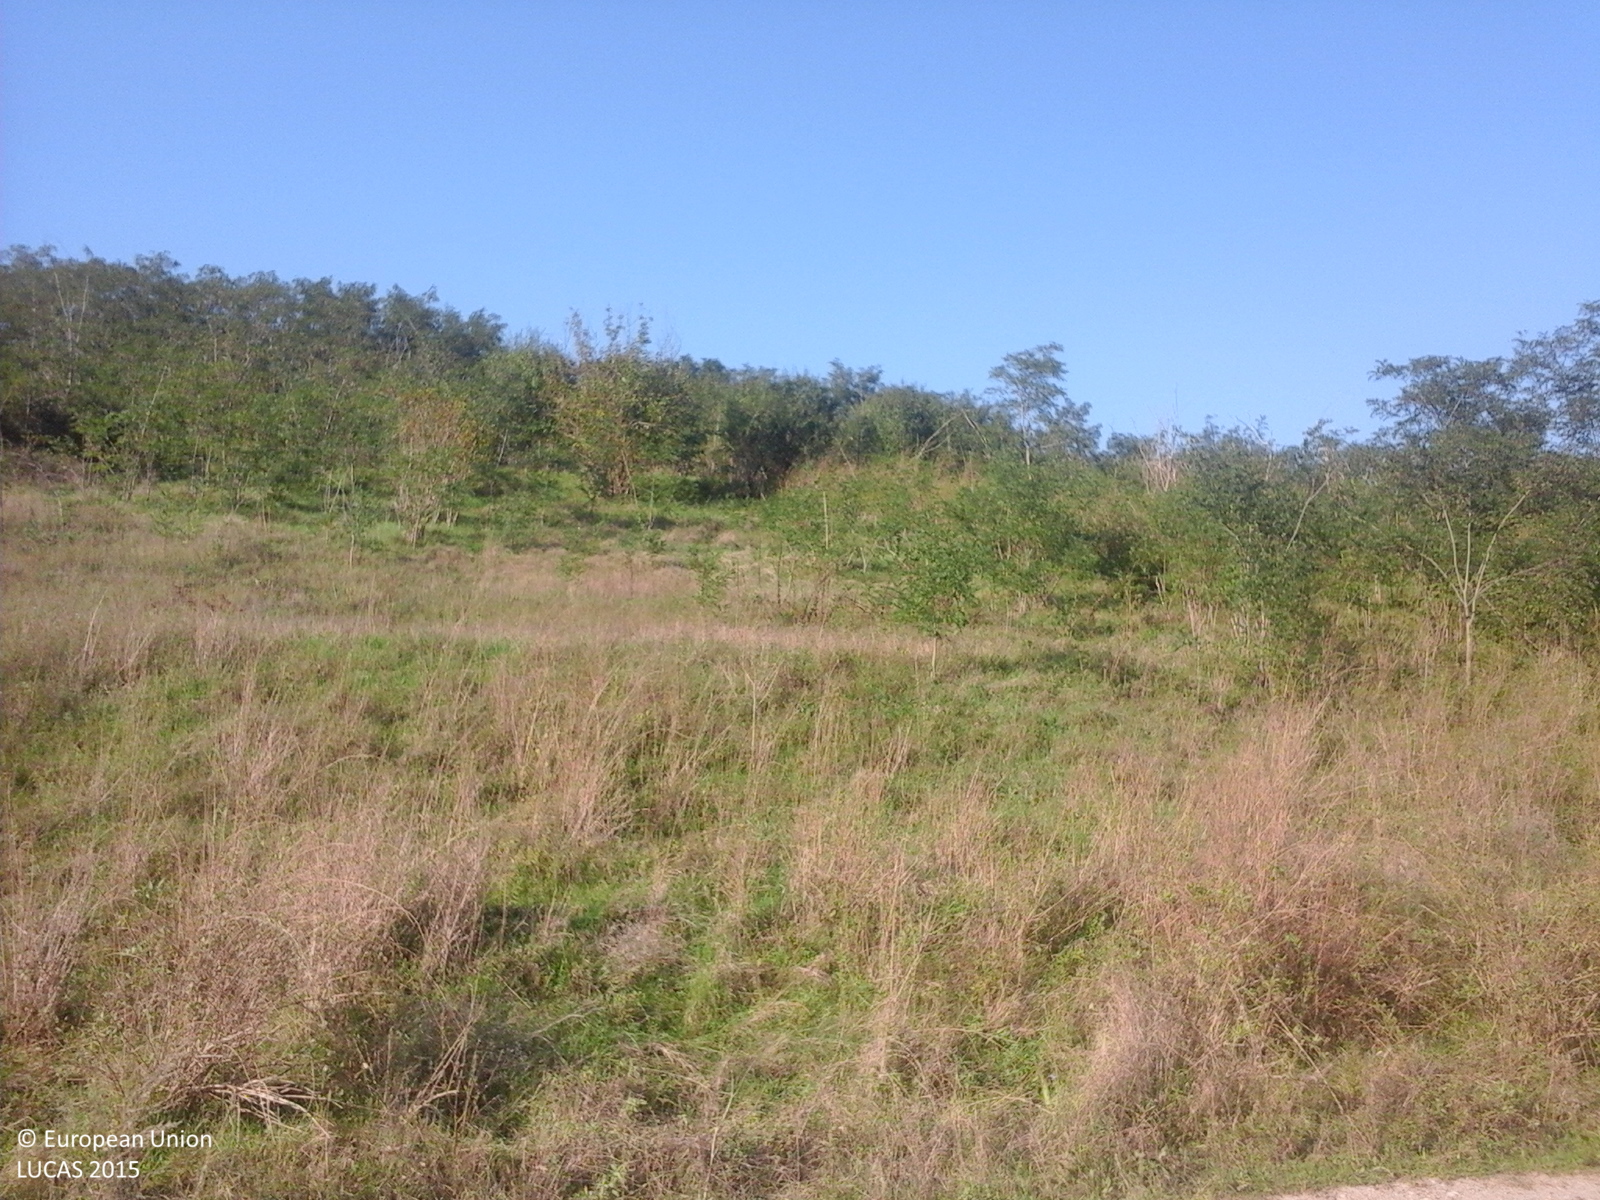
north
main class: Grassland
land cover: Grassland without tree/shrub cover
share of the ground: > 75 %
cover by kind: herbaceous plants 100 %
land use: Agriculture (excluding fallow land and kitchen gardens)
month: October
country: RO
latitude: 46.3665
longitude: 23.7854
